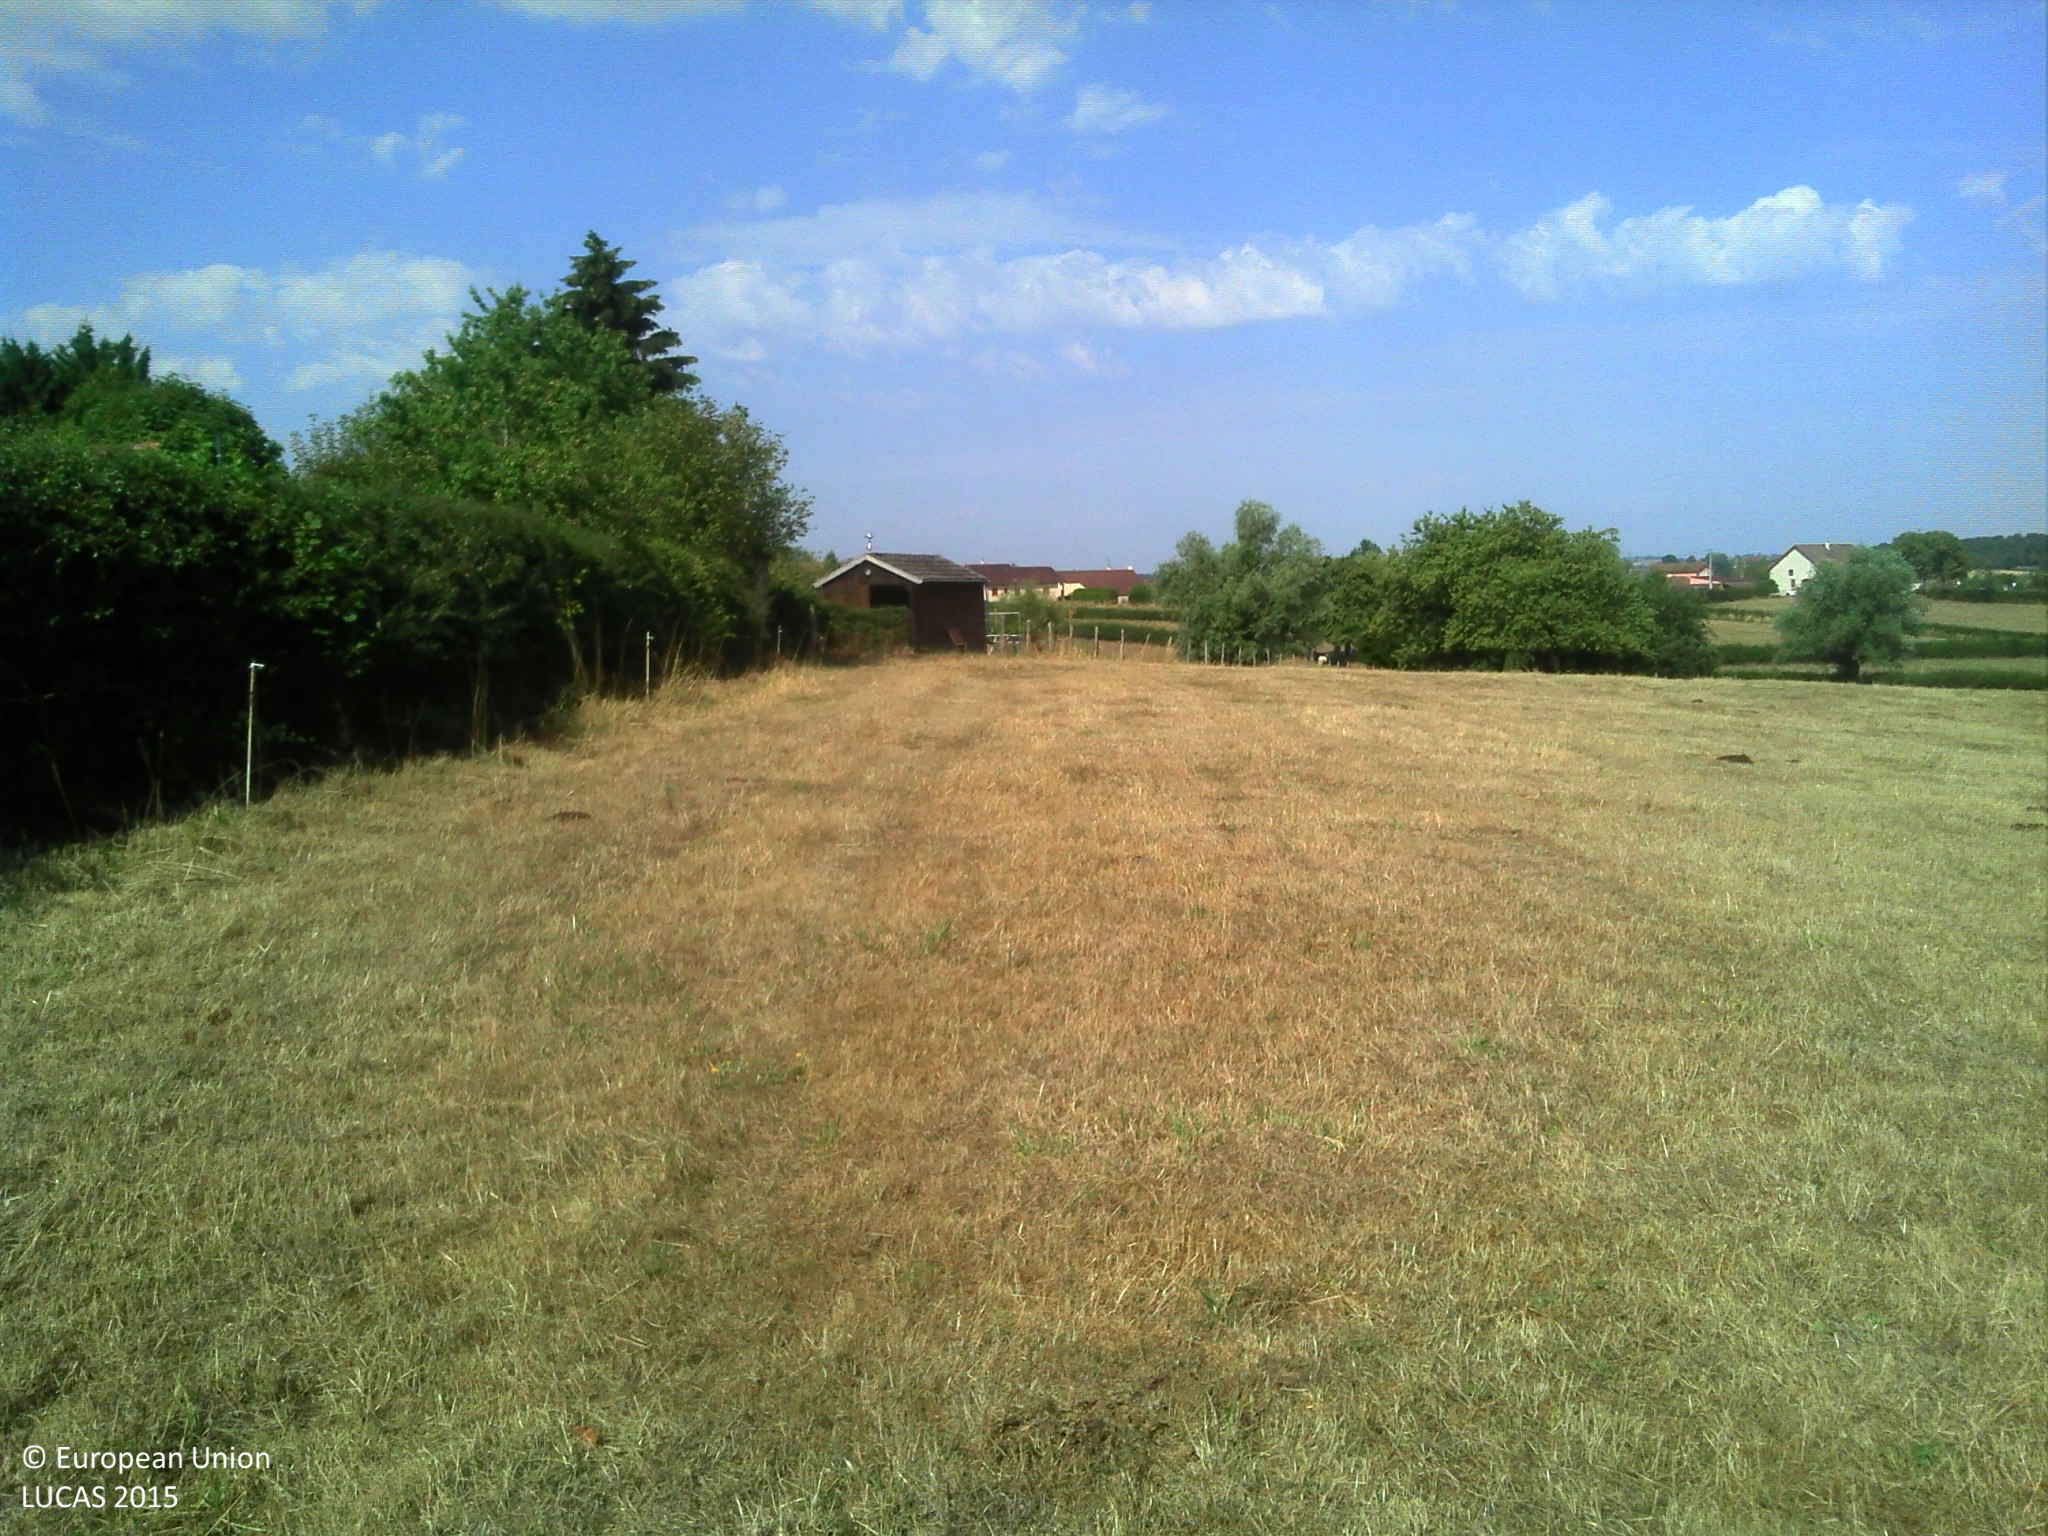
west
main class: Grassland
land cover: Grassland without tree/shrub cover
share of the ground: > 75 %
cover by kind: herbaceous plants 100 %
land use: Agriculture (excluding fallow land and kitchen gardens)
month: August
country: FR
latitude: 46.7094
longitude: 4.3891
